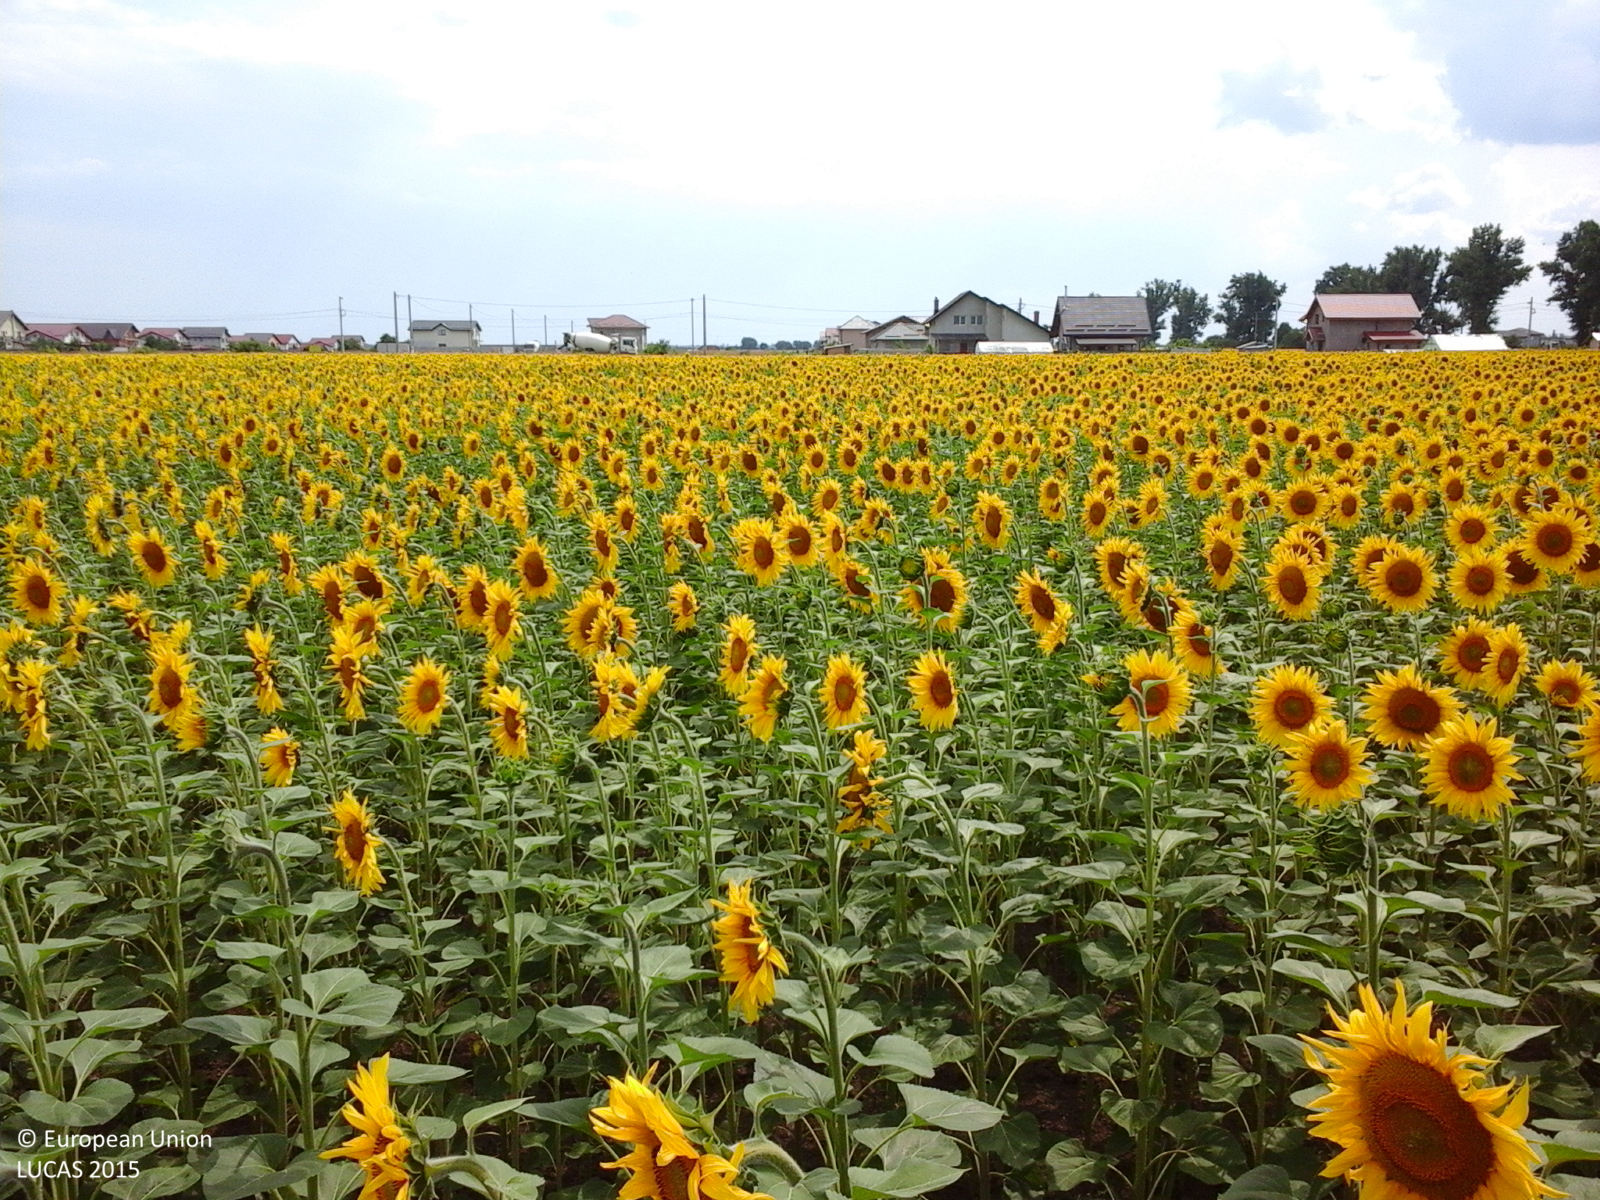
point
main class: Cropland
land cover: Sunflower
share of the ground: > 75 %
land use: Agriculture (excluding fallow land and kitchen gardens)
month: June
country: RO
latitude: 44.2824
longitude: 26.1821
